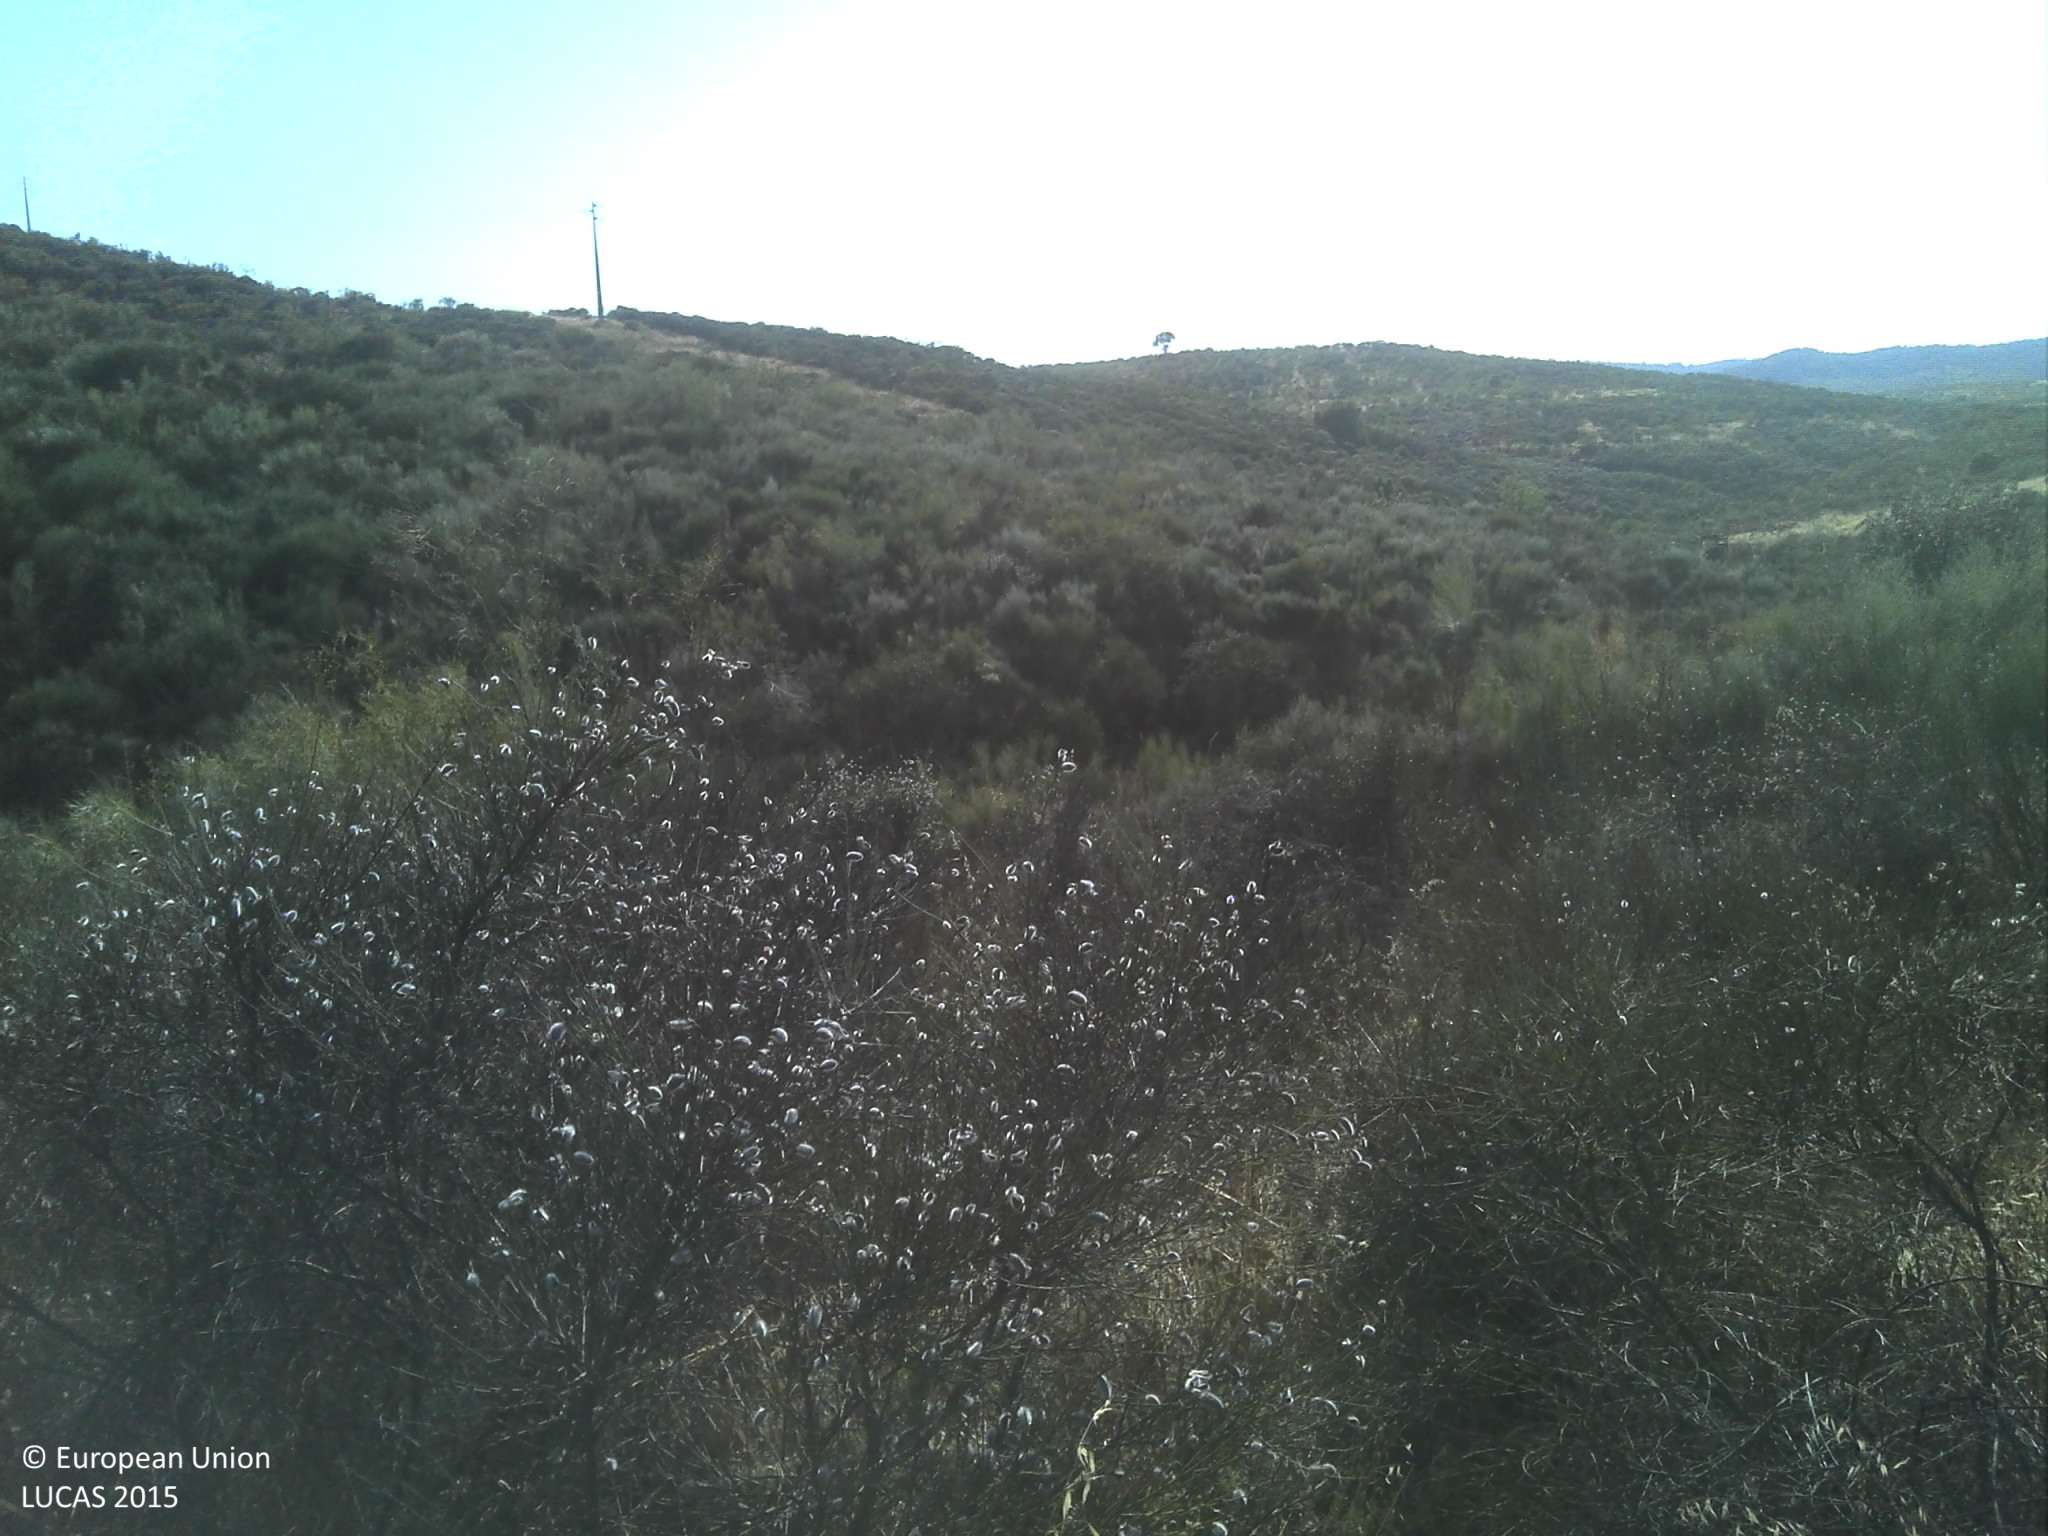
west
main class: Shrubland
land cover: Shrubland without tree cover
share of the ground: 50 - 75 %
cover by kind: shrubs 70 %, herbaceous plants 15 %, unconsolidated bare surface 10 %
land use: Abandoned areas
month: June
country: PT
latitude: 39.8021
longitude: -7.0111
